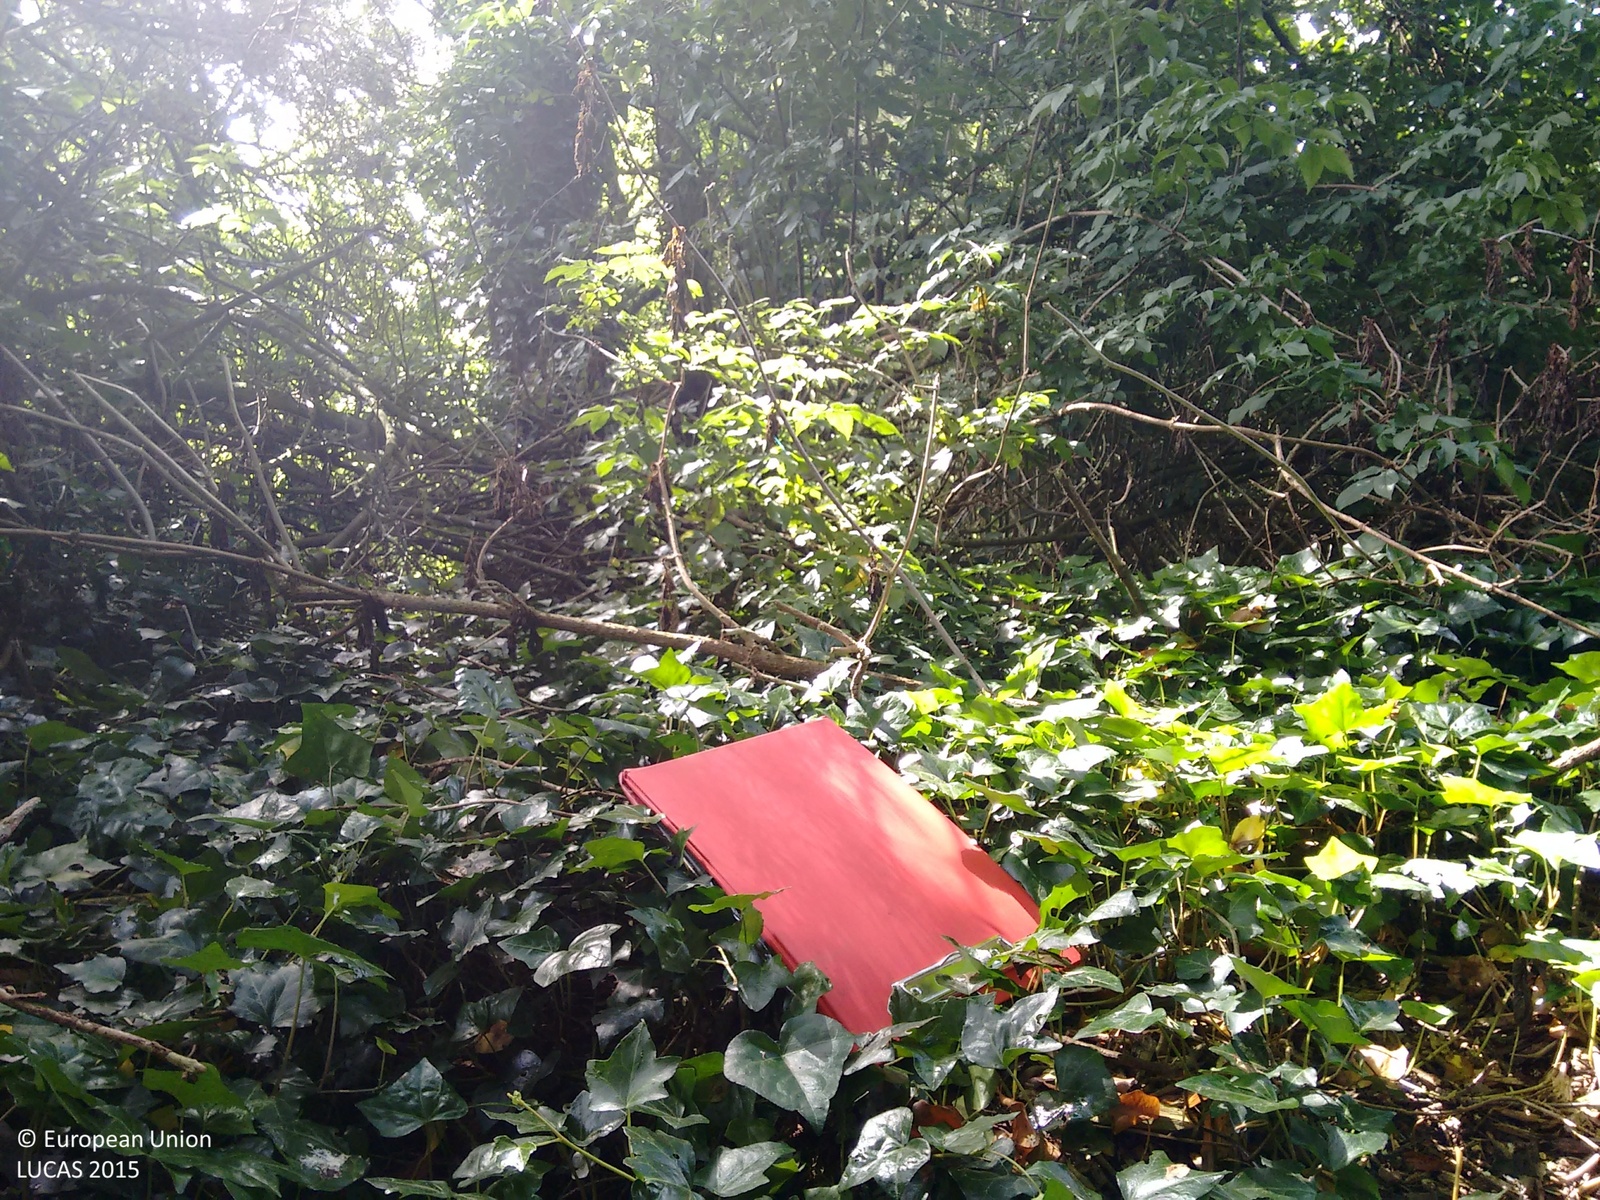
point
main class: Woodland
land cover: Broadleaved woodland
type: mesophytic deciduous forest
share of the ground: > 75 %
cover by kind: broadleaved forest trees 60 %, coniferous forest trees 20 %, shrubs 20 %
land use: Semi-natural and natural areas not in use
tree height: > 5 m
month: June
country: IE
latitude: 53.6987
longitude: -6.7181
